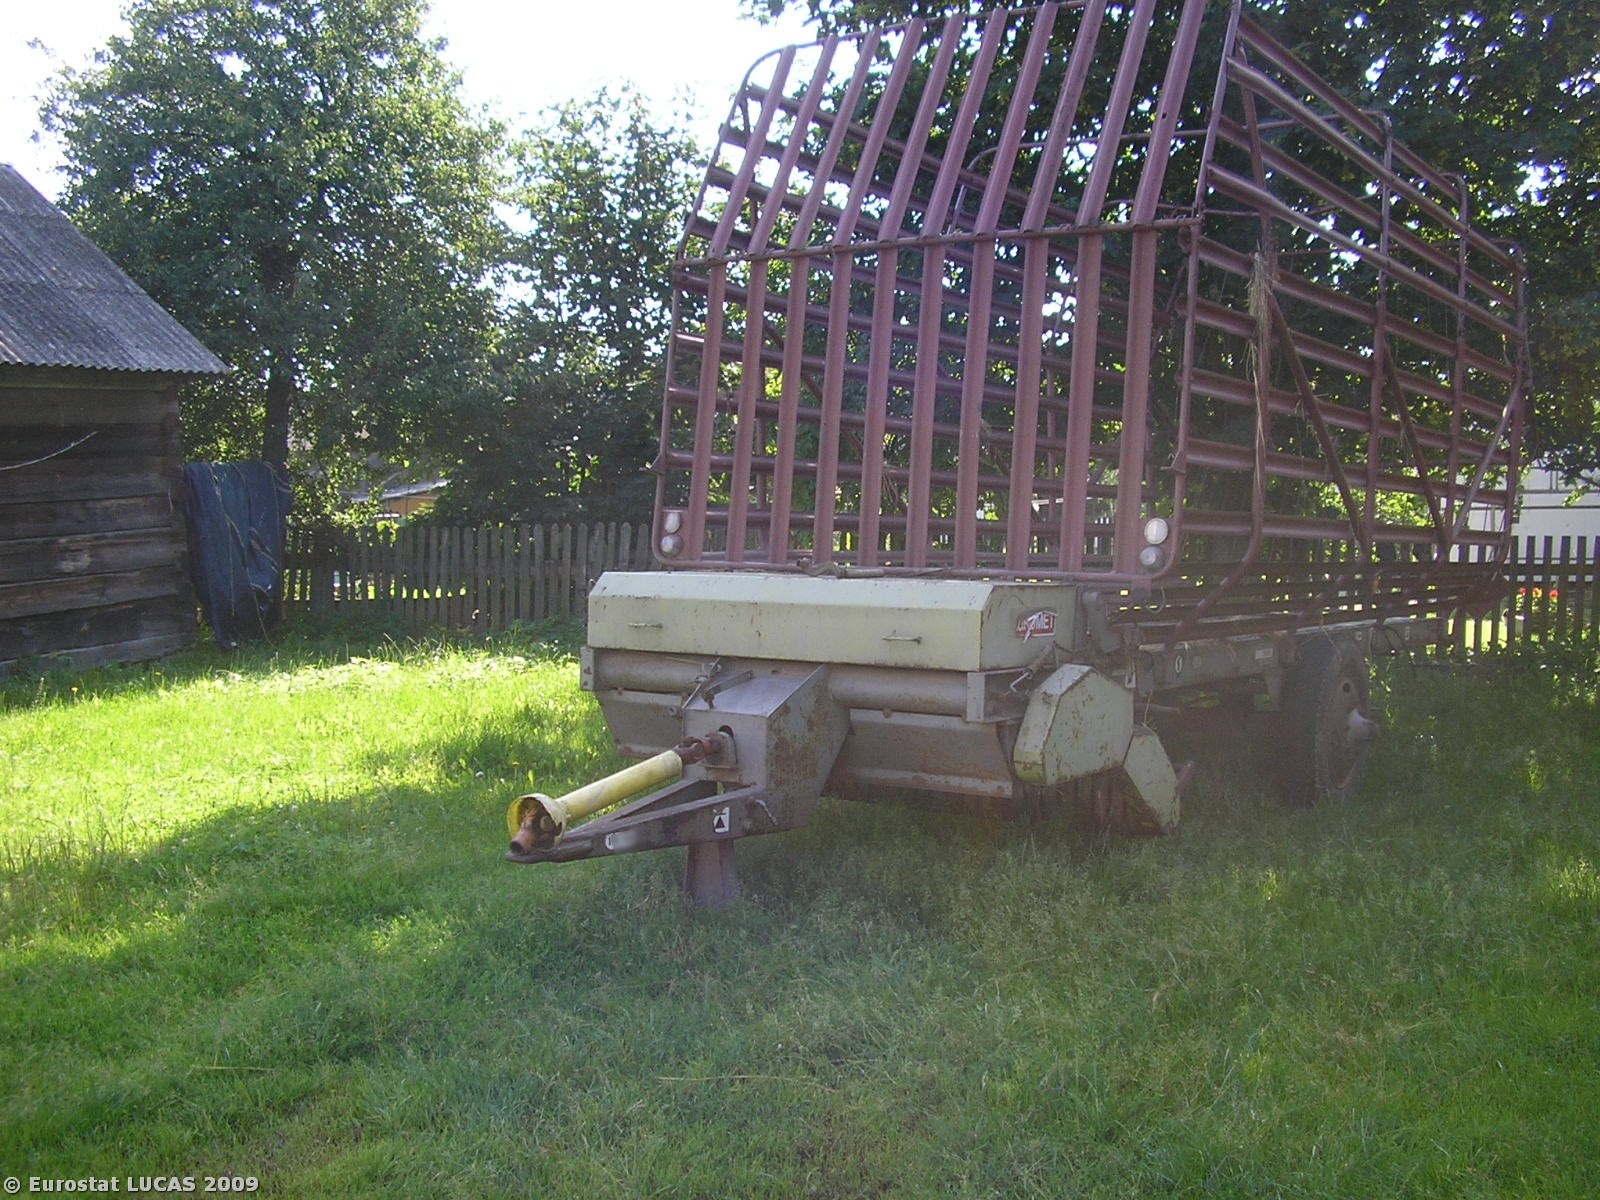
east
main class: Grassland
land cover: Grassland without tree/shrub cover
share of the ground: > 75 %
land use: Residential
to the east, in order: Grassland without tree/shrub cover; Fences; Grassland with sparse tree/shrub cover; Artificial constructions in urban areas; Fences; Artificial constructions in urban areas; Grassland without tree/shrub cover; Artificial constructions in urban areas; Grassland without tree/shrub cover; Artificial constructions in urban areas; Fences; Tracks; Artificial constructions in urban areas; Fences; Single bushes/trees; Grassland without tree/shrub cover; Artificial constructions in urban areas; Fences; Grassland with sparse tree/shrub cover; Tracks; Rye; Potatoes; Grassland with sparse tree/shrub cover; Strawberries; Grassland with sparse tree/shrub cover
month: July
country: PL
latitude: 51.9181
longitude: 22.1133
